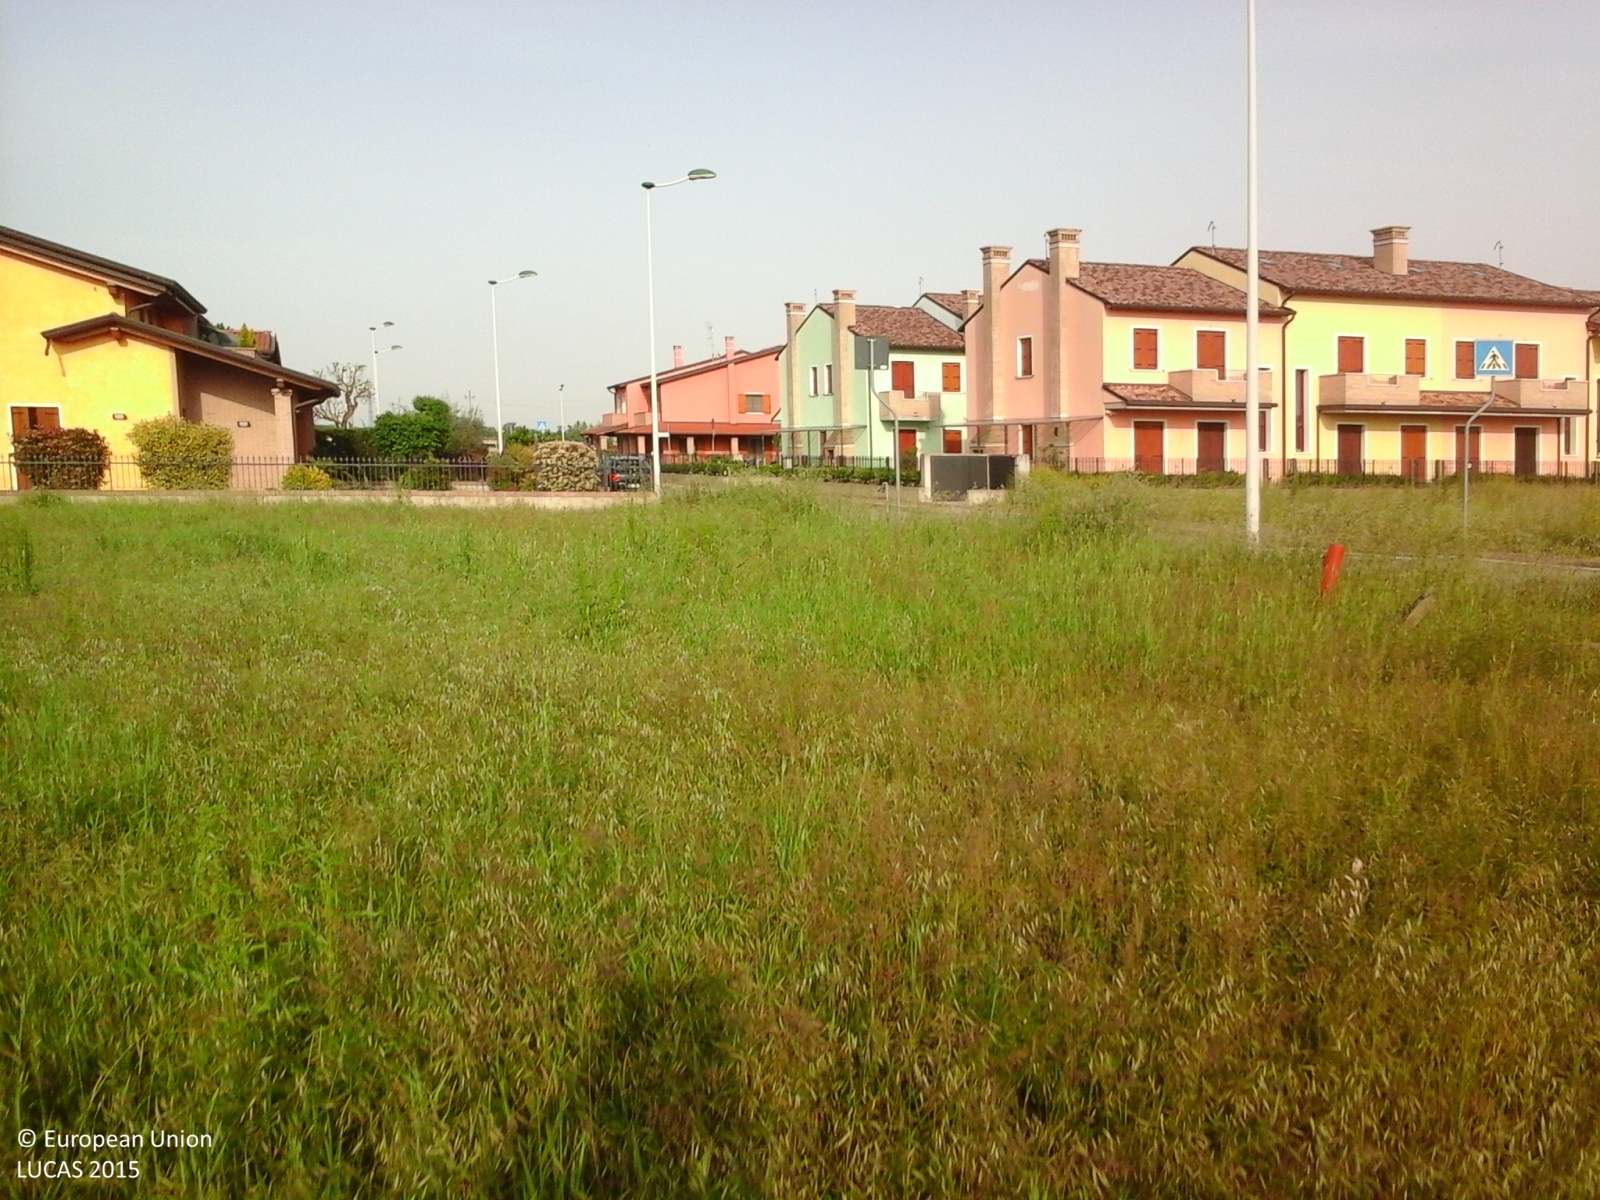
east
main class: Grassland
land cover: Spontaneously vegetated surfaces
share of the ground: > 75 %
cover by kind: herbaceous plants 100 %
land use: Abandoned areas
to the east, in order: Spontaneously vegetated surfaces; Artificial constructions in urban areas; Maize
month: May
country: IT
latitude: 45.1840
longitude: 11.7150
